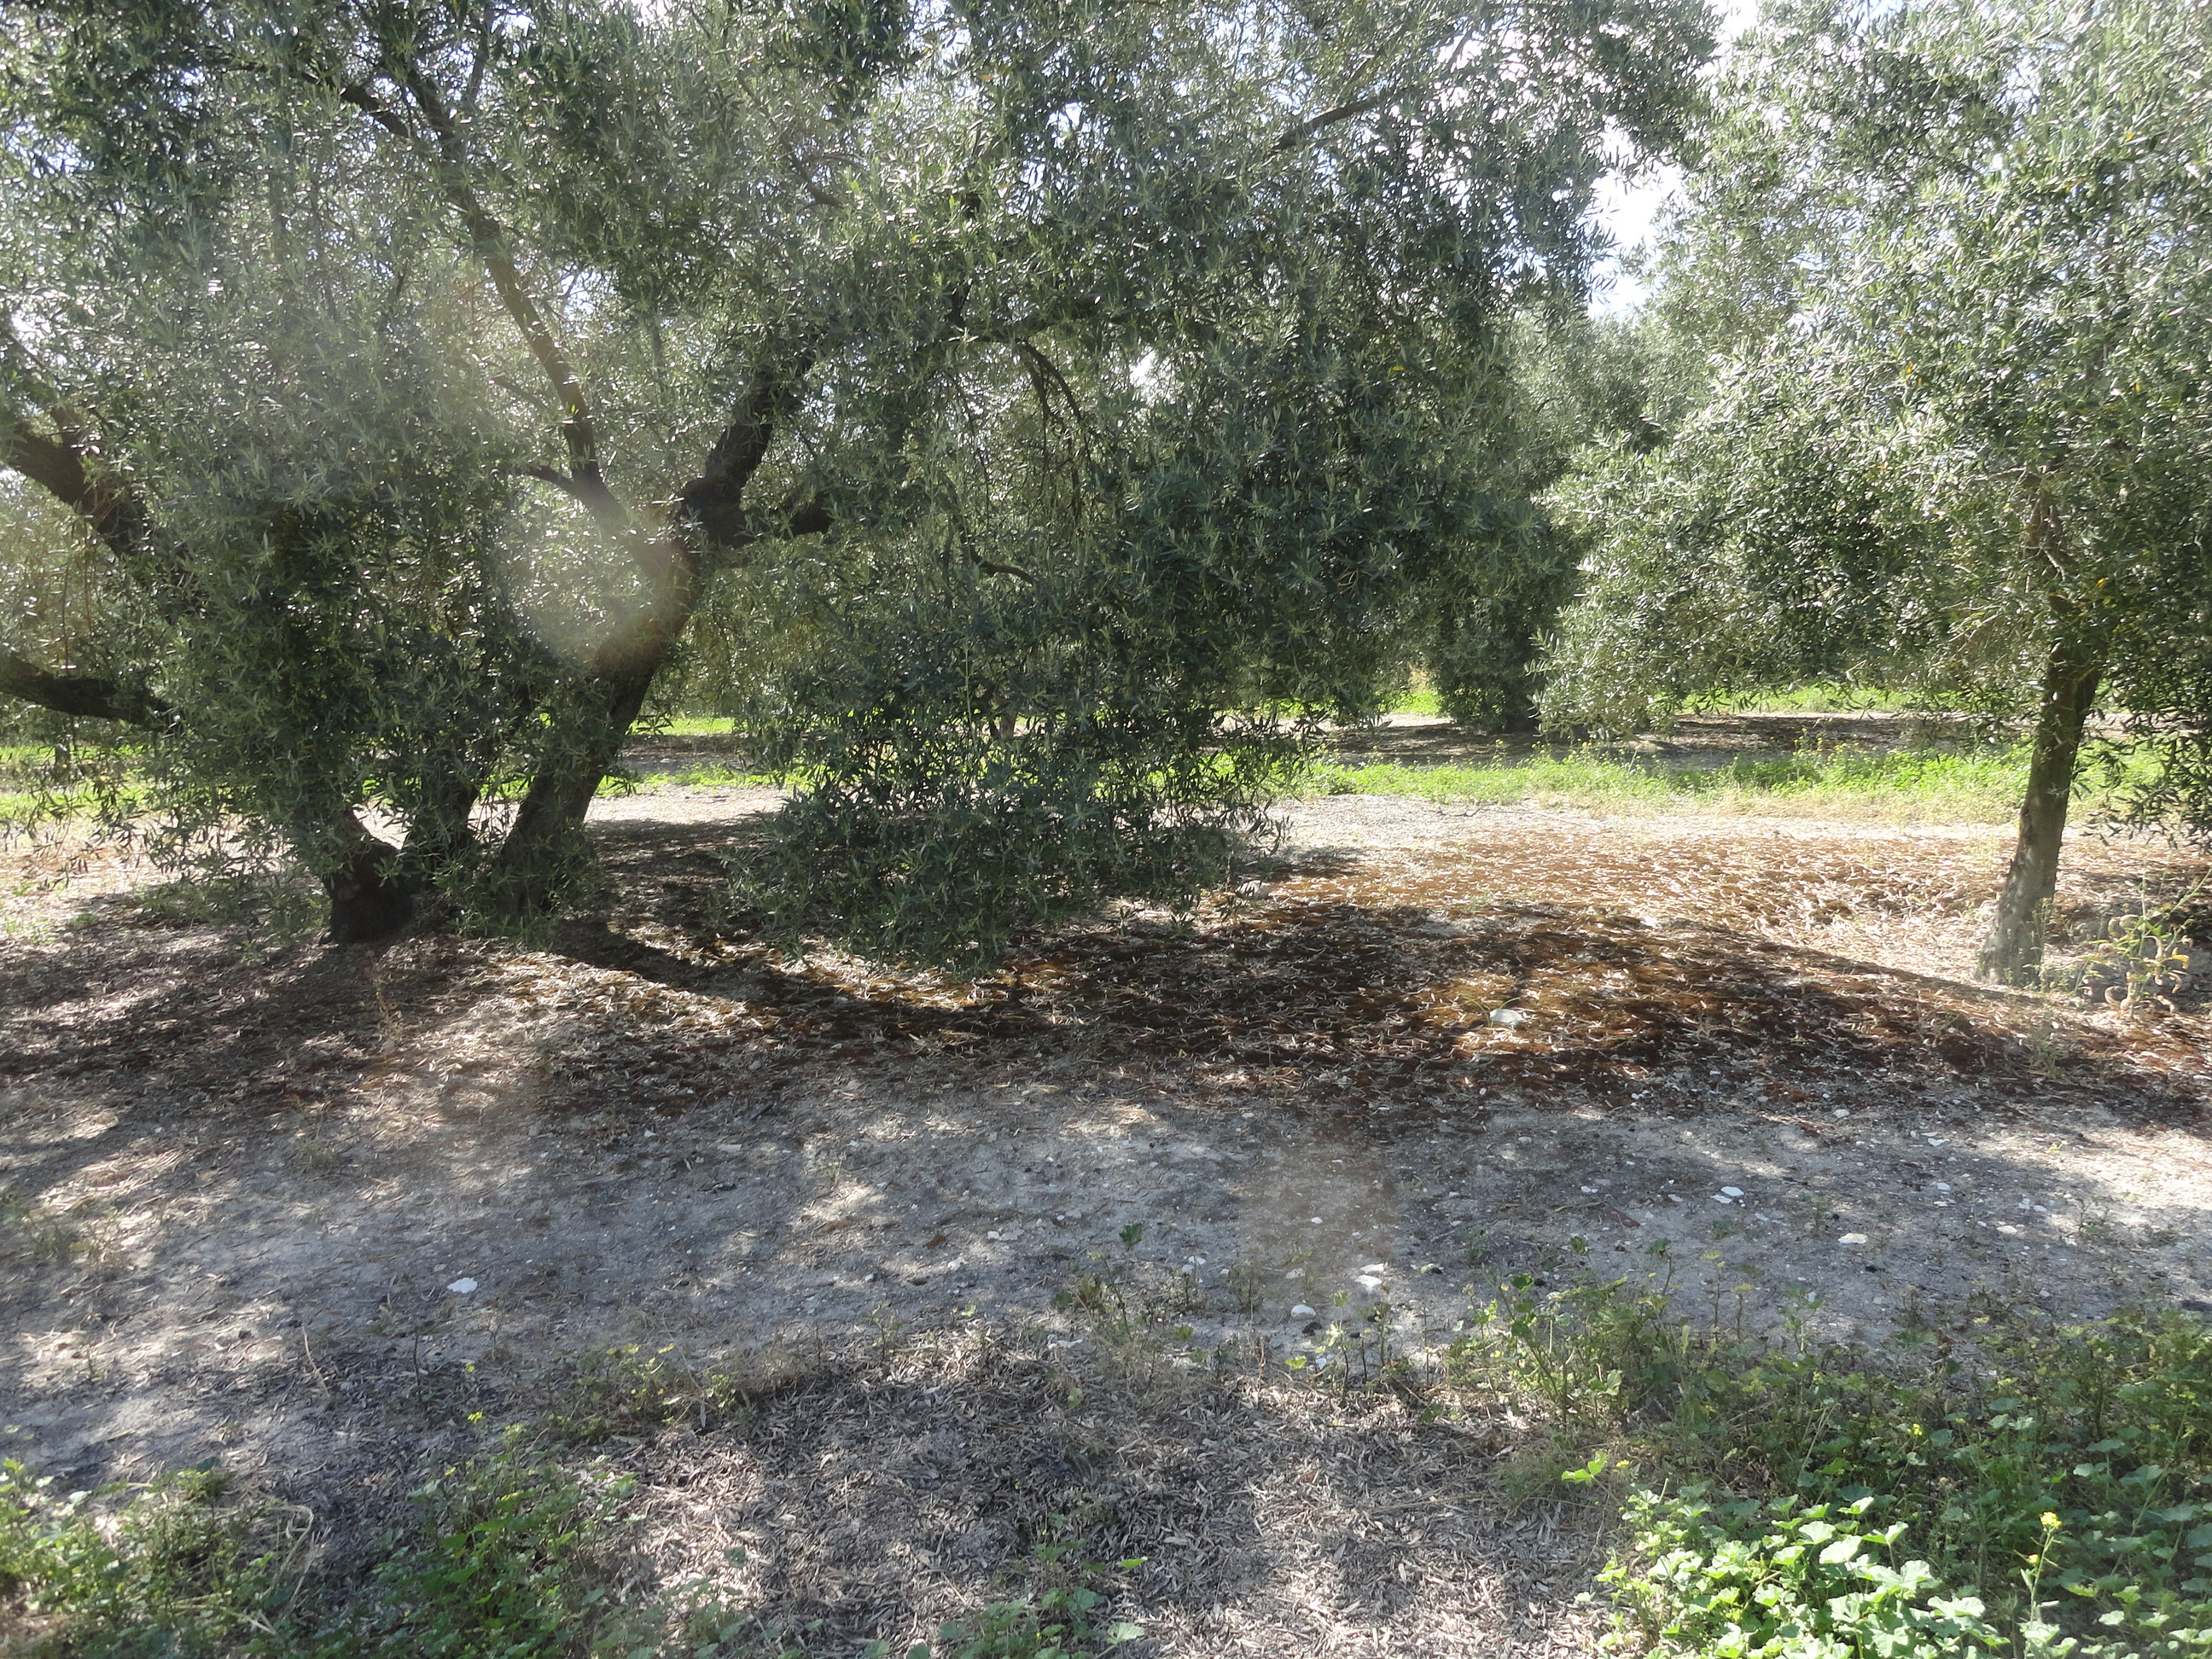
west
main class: Cropland
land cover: Olive groves
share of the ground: 50 - 75 %
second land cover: Spontaneously vegetated surfaces
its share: 10 - 25 %
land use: Agriculture (excluding fallow land and kitchen gardens)
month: April
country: ES
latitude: 37.5485
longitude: -4.5046
